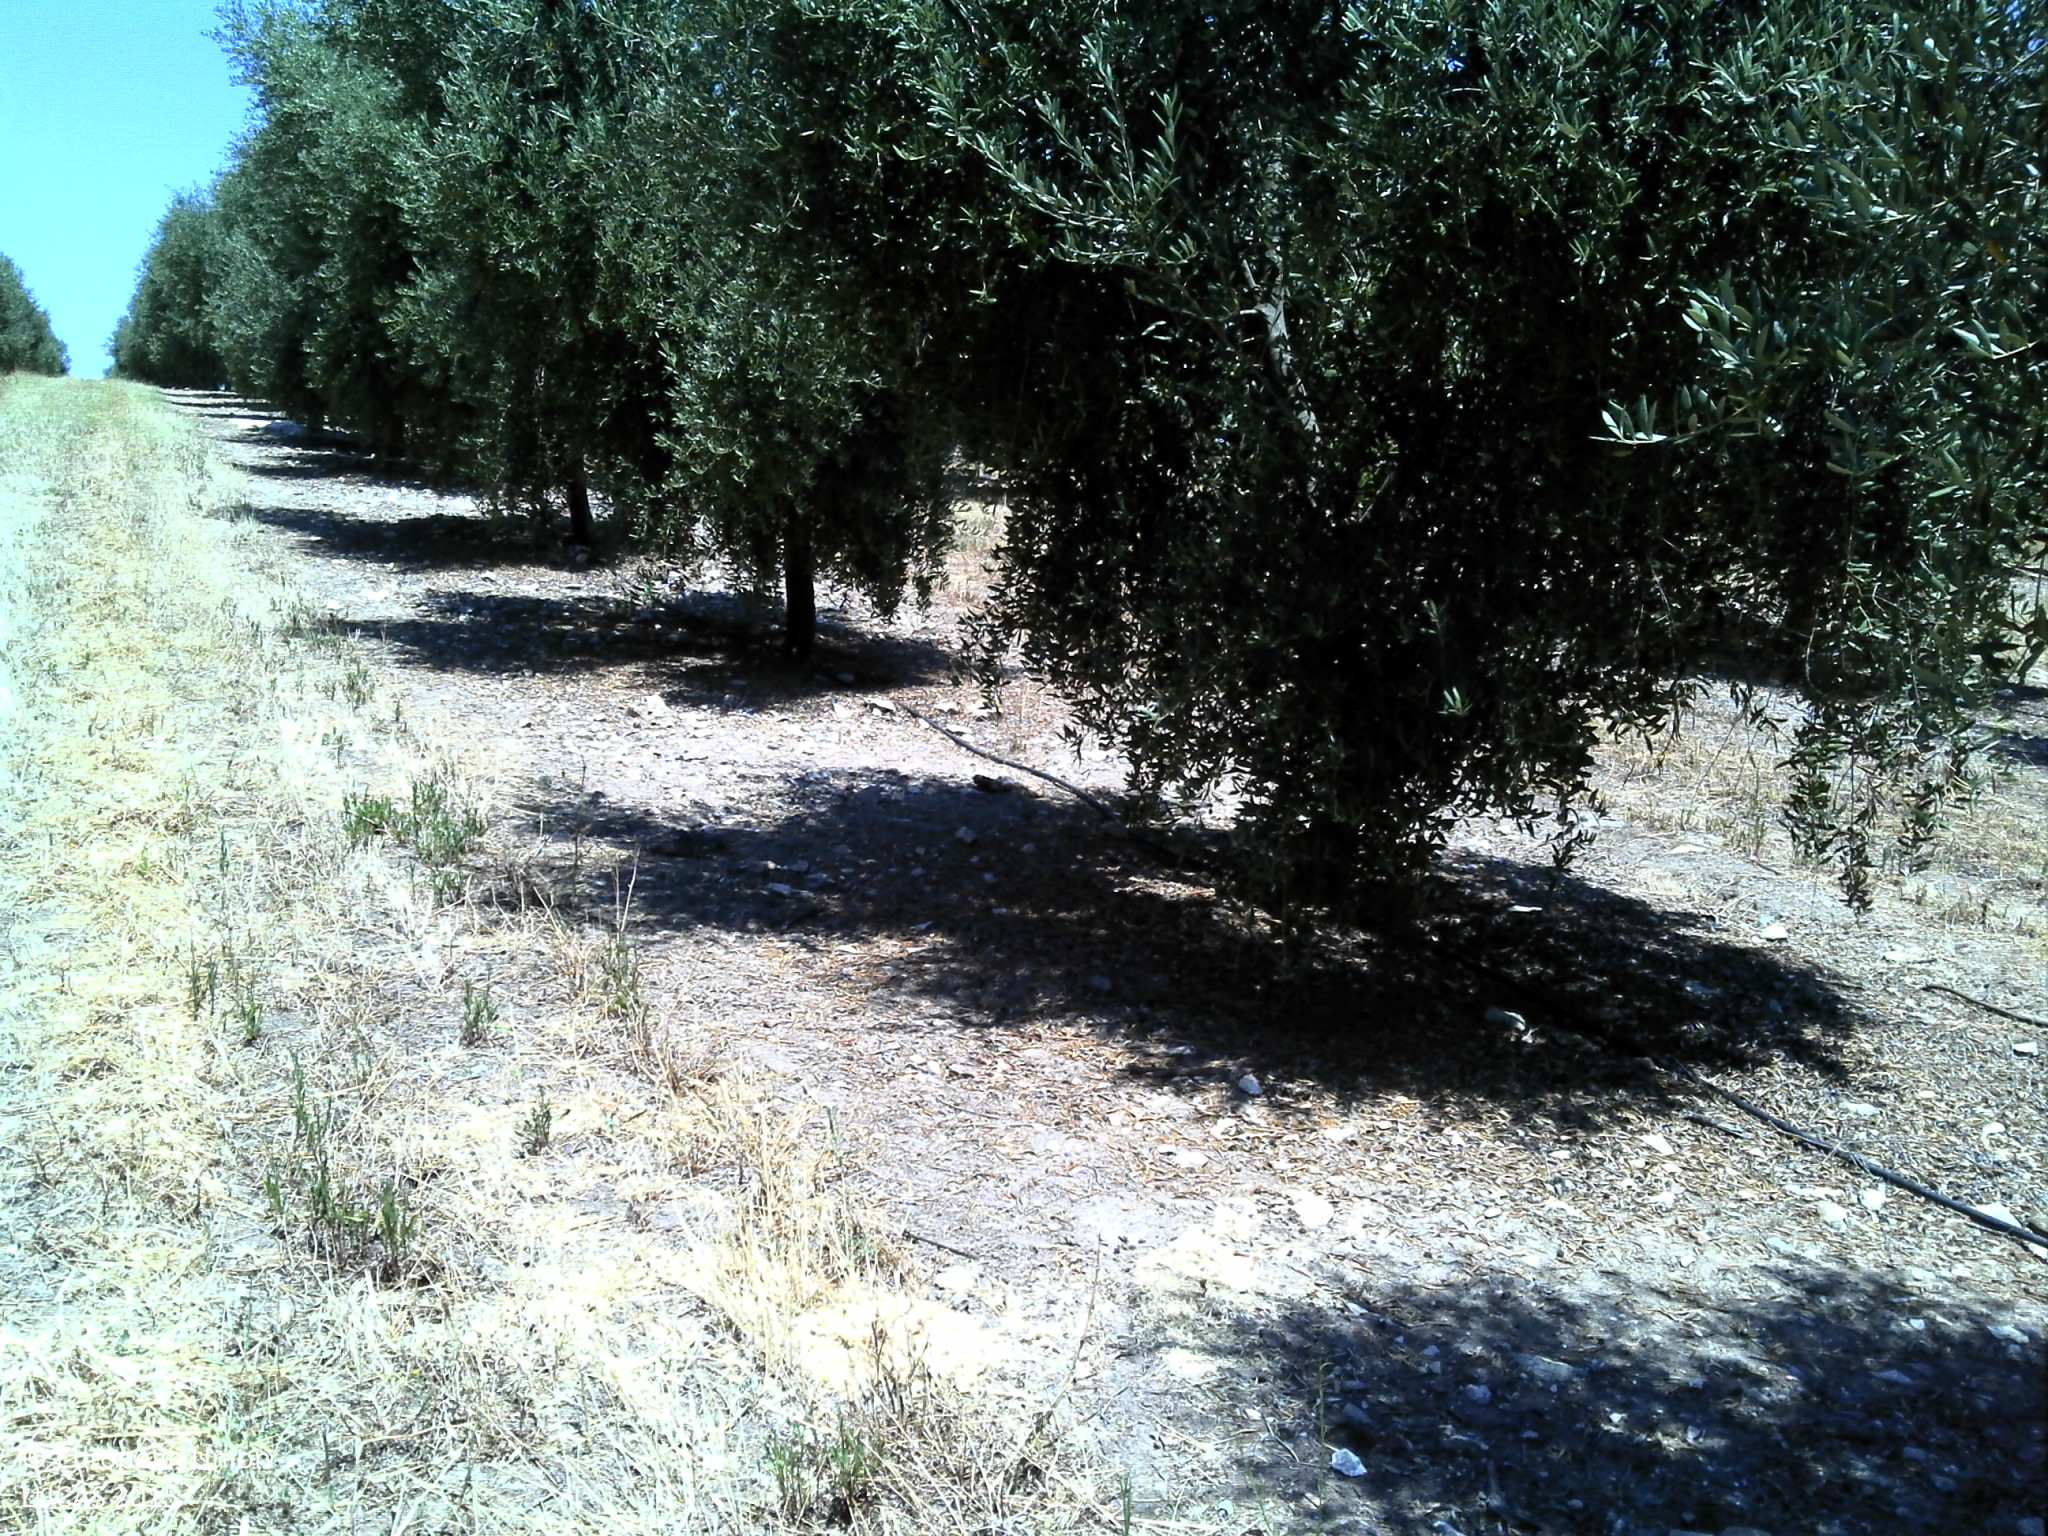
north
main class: Cropland
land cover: Olive groves
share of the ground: 25 - 50 %
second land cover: Grassland without tree/shrub cover
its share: 10 - 25 %
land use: Agriculture (excluding fallow land and kitchen gardens)
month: June
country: PT
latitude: 37.9984
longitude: -7.5924
